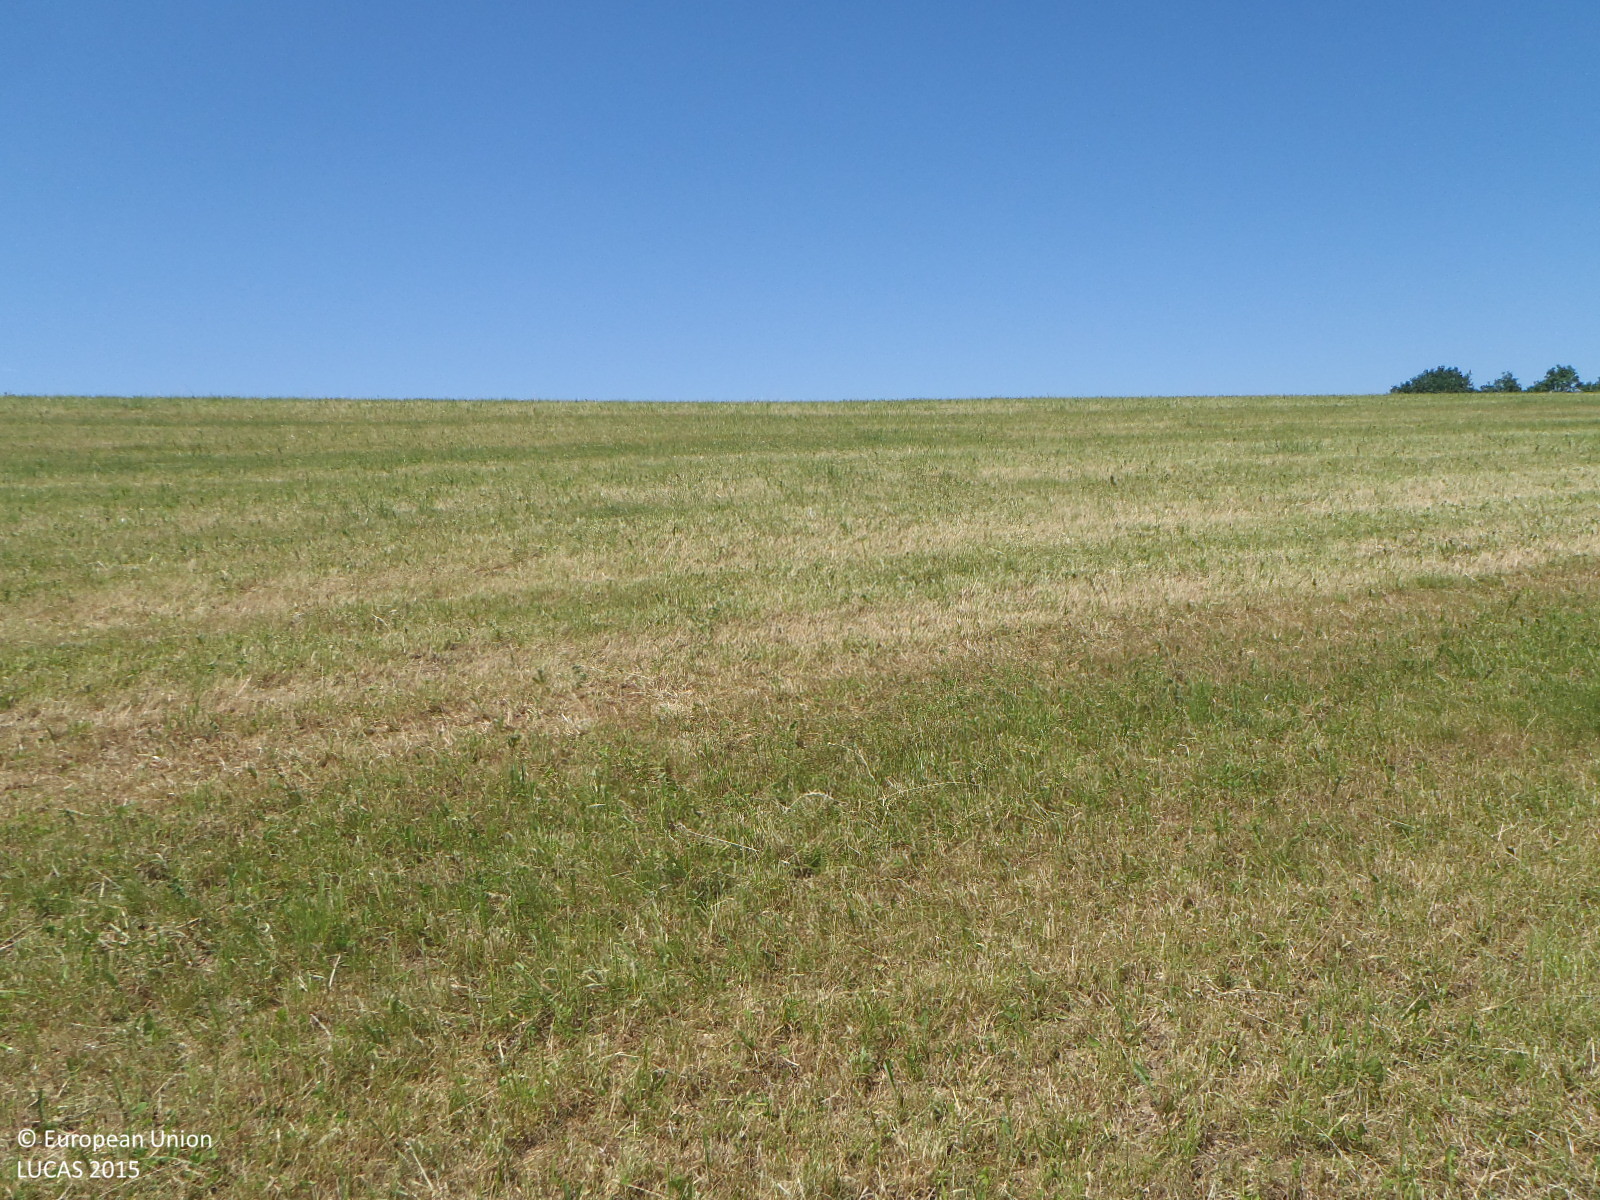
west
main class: Grassland
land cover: Grassland without tree/shrub cover
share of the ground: > 75 %
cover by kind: herbaceous plants 100 %
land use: Agriculture (excluding fallow land and kitchen gardens)
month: June
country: CZ
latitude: 48.8722
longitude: 14.4593
